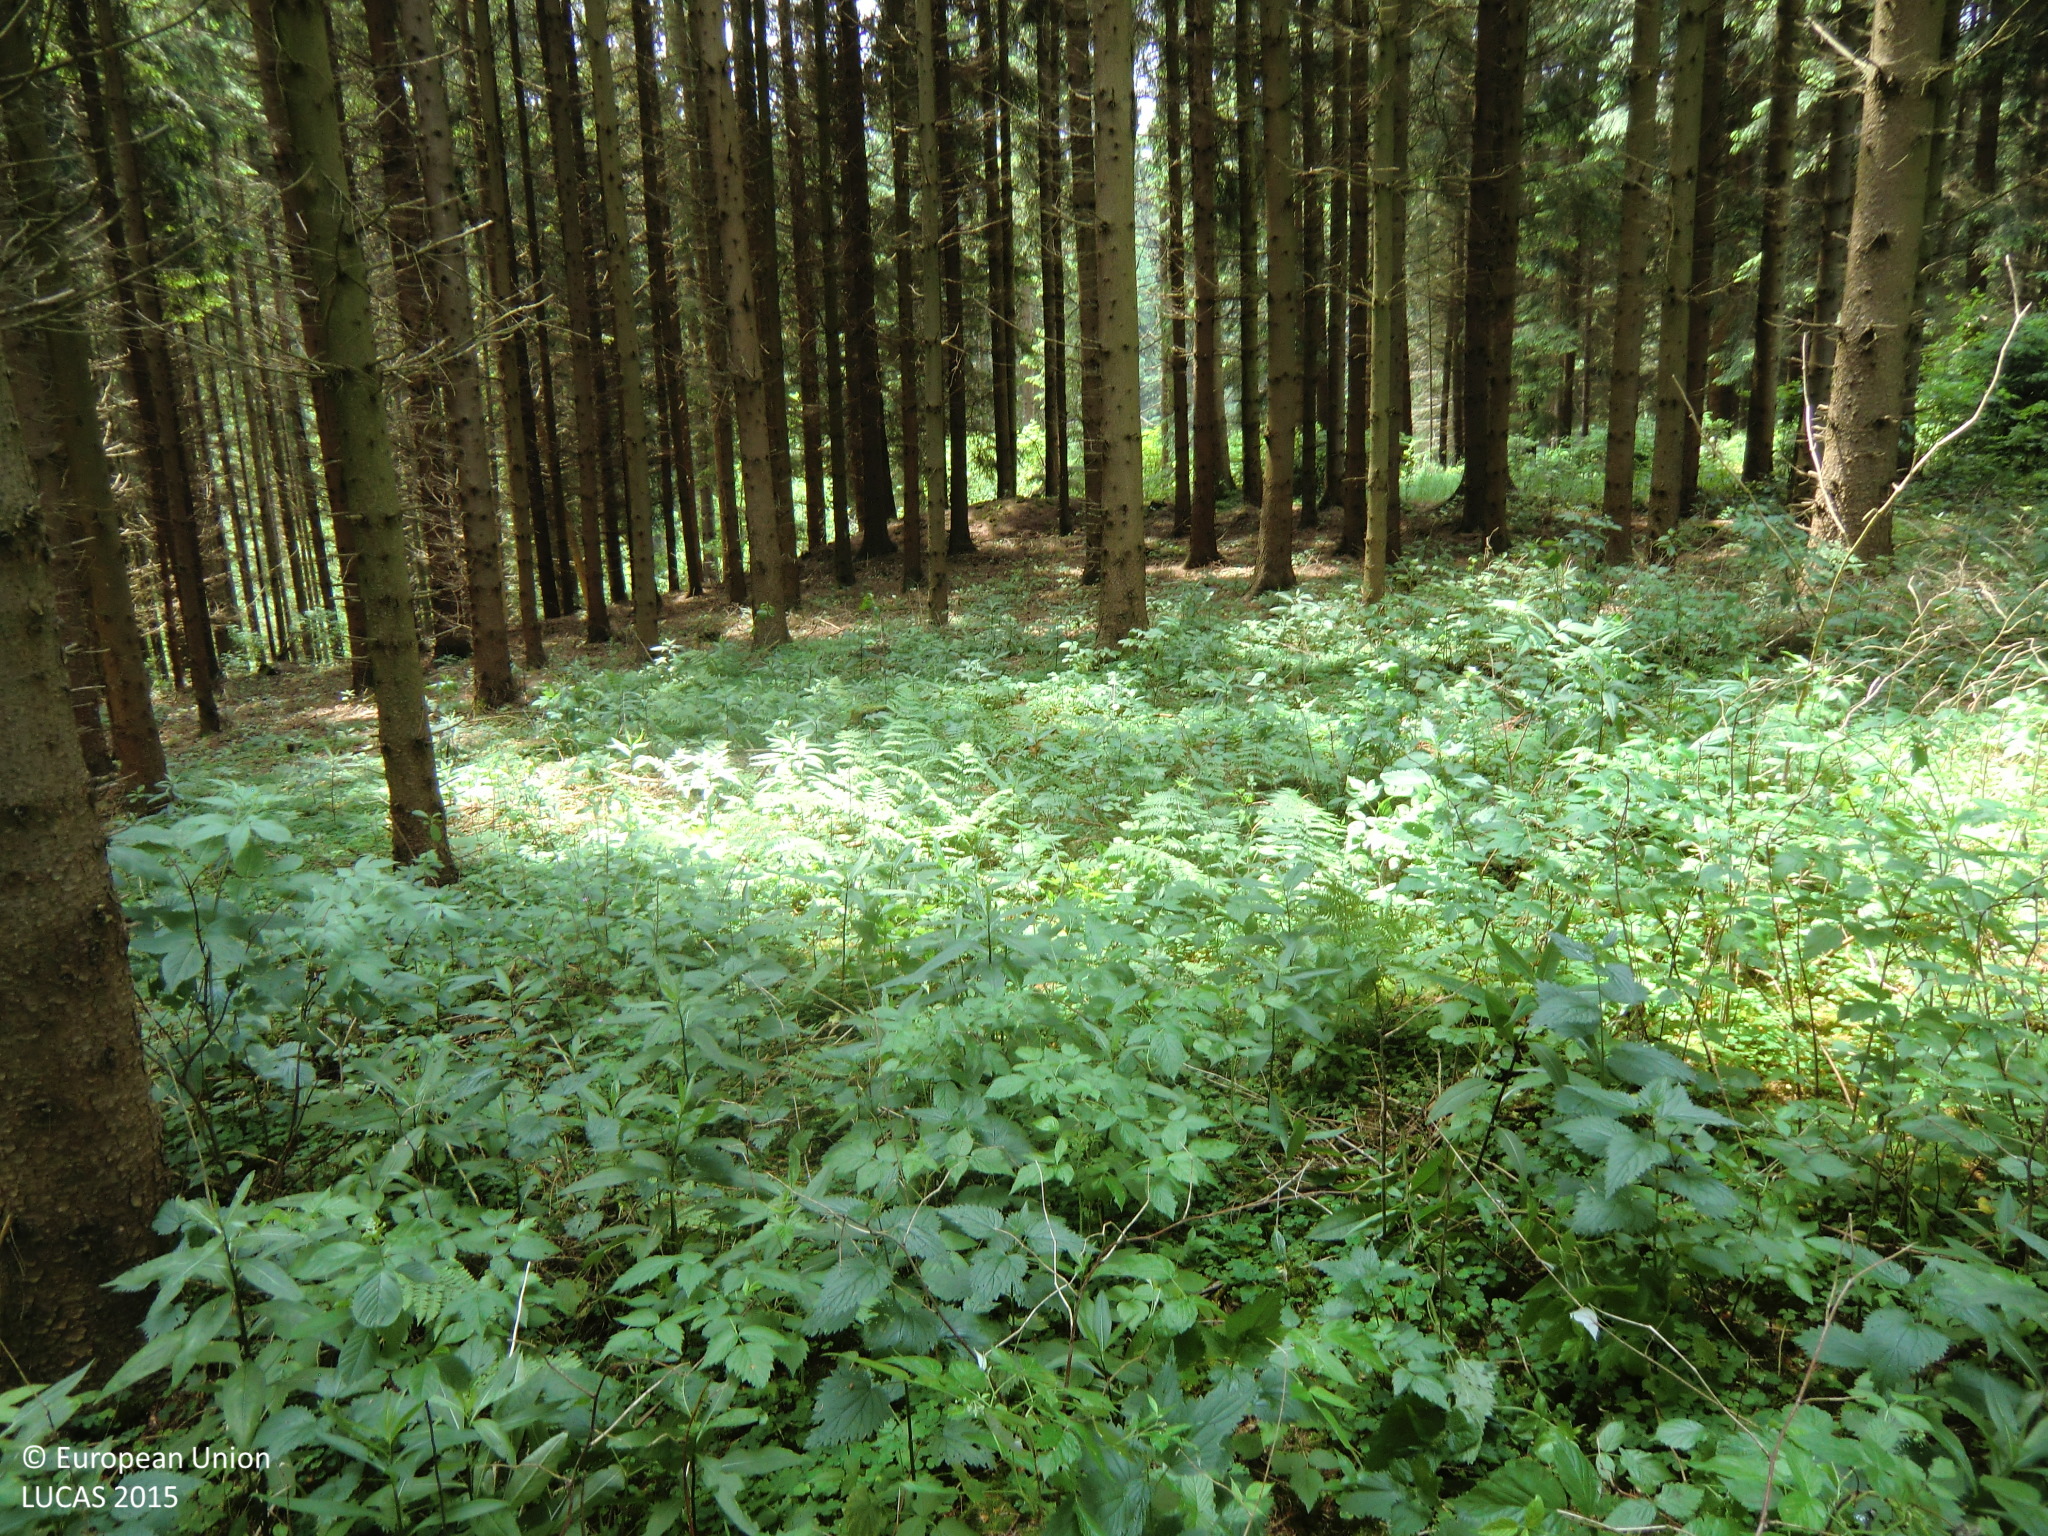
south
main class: Woodland
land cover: Spruce dominated coniferous woodland
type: hemiboreal forest and nemoral coniferous forest and mixed broadleaved-coniferous forest
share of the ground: > 75 %
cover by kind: coniferous forest trees 90 %, herbaceous plants 10 %
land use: Forestry
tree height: > 5 m
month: June
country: AT
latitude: 48.6206
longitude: 14.8717
